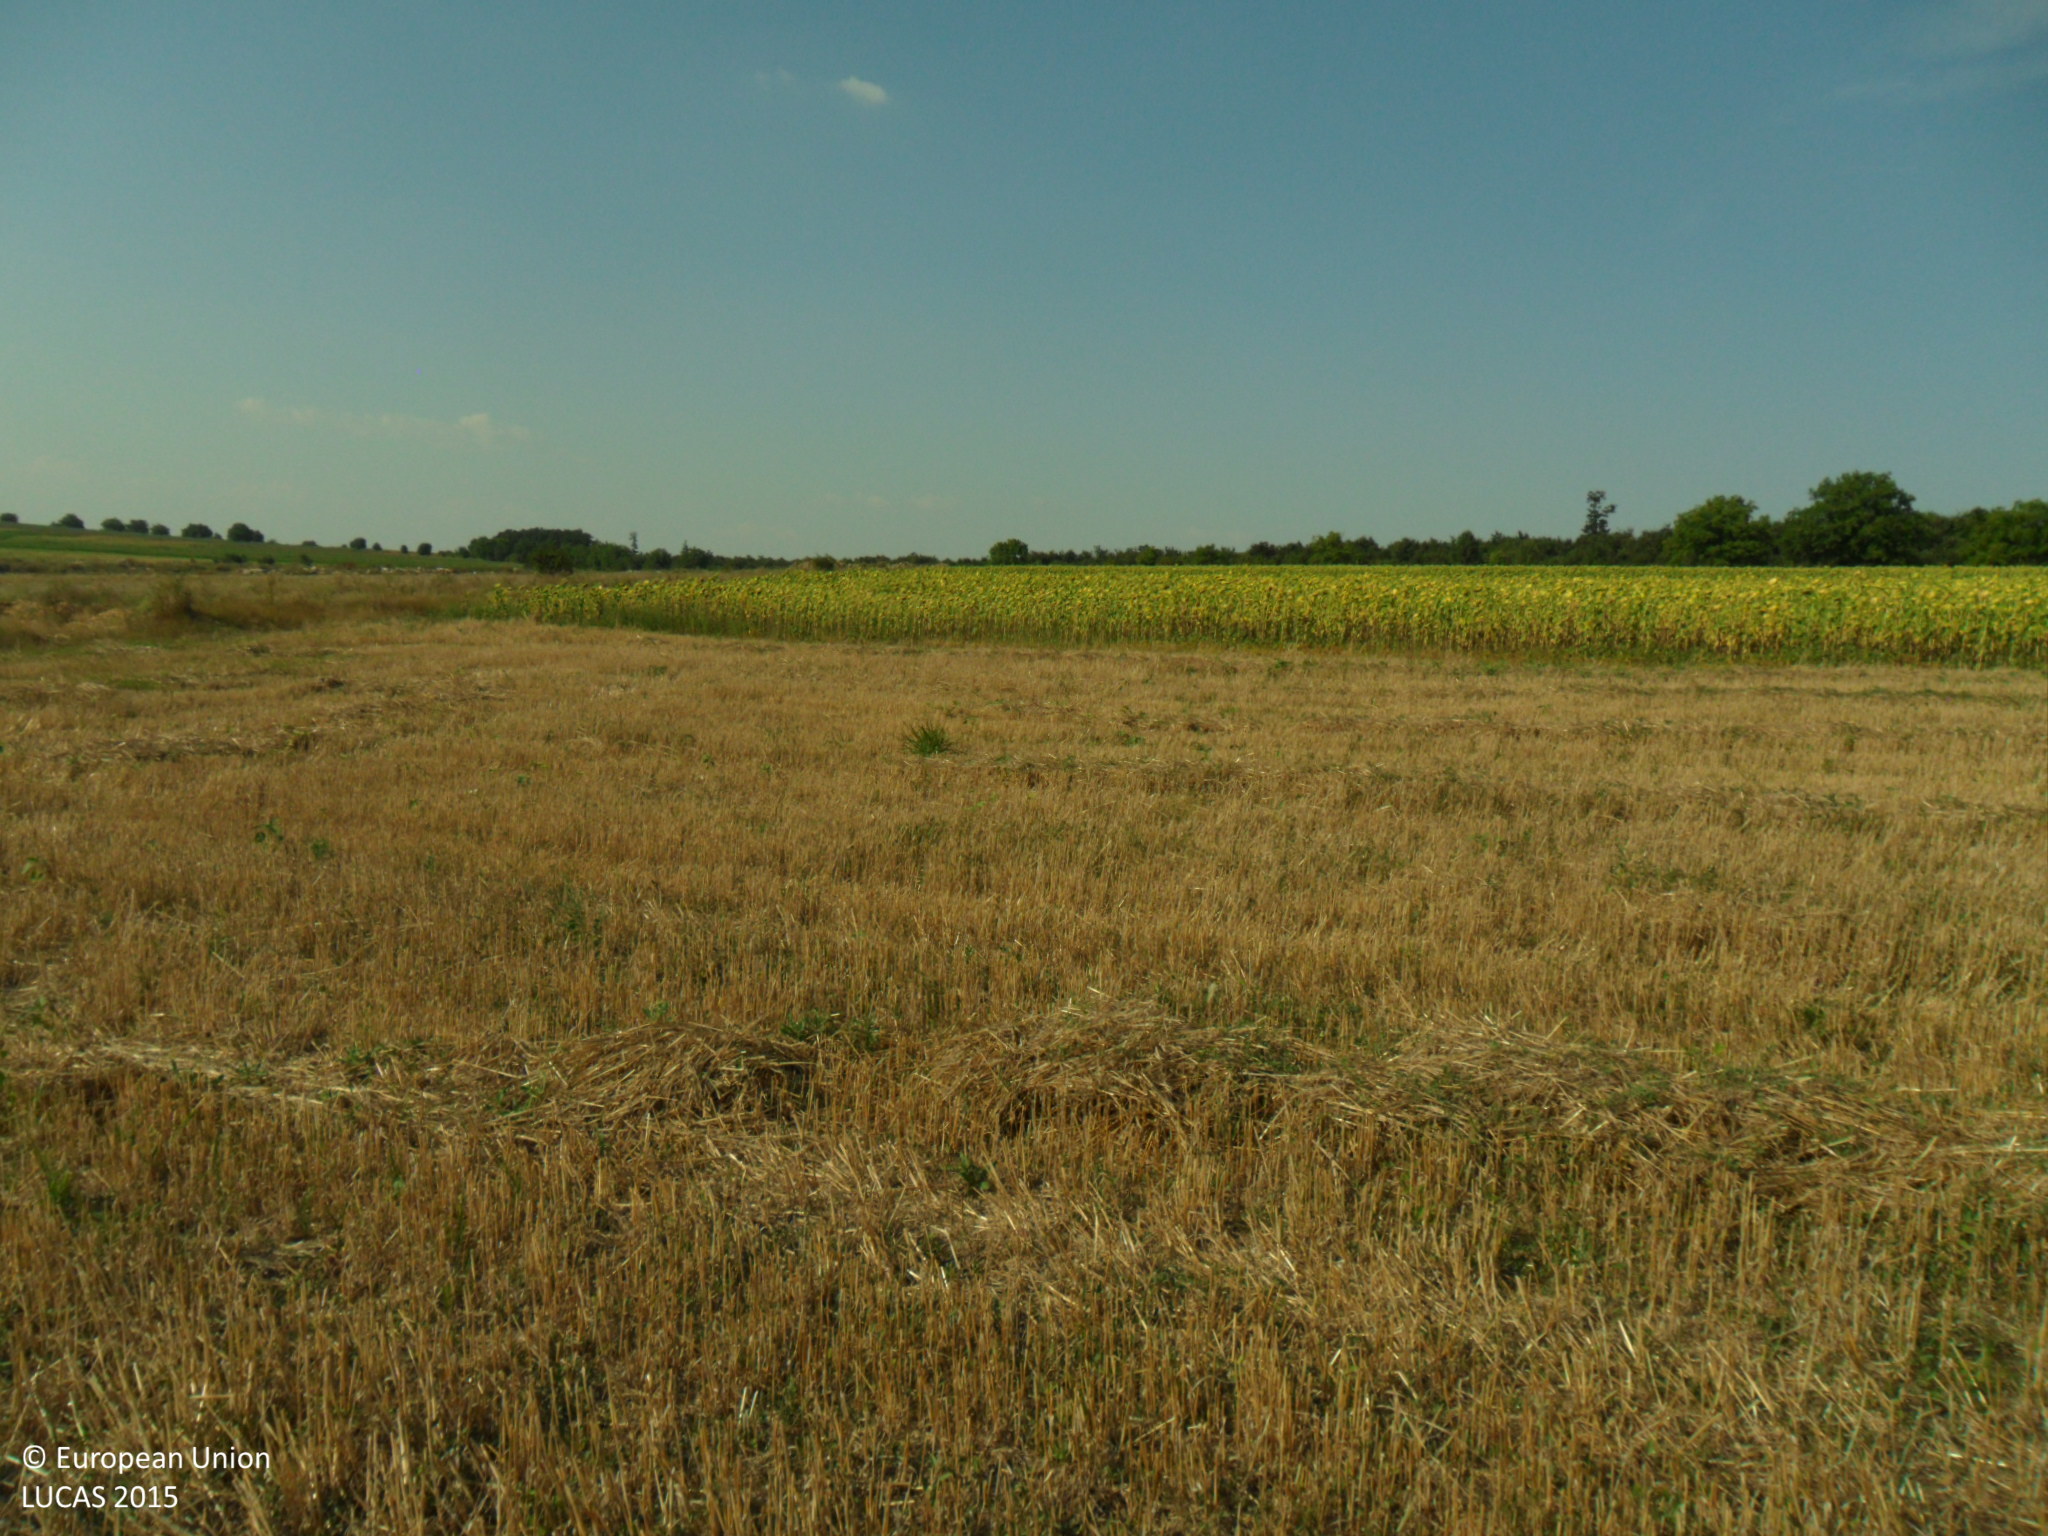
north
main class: Cropland
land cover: Barley
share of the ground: 50 - 75 %
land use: Agriculture (excluding fallow land and kitchen gardens)
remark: Harvested field
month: August
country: BG
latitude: 43.6376
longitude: 27.0911
